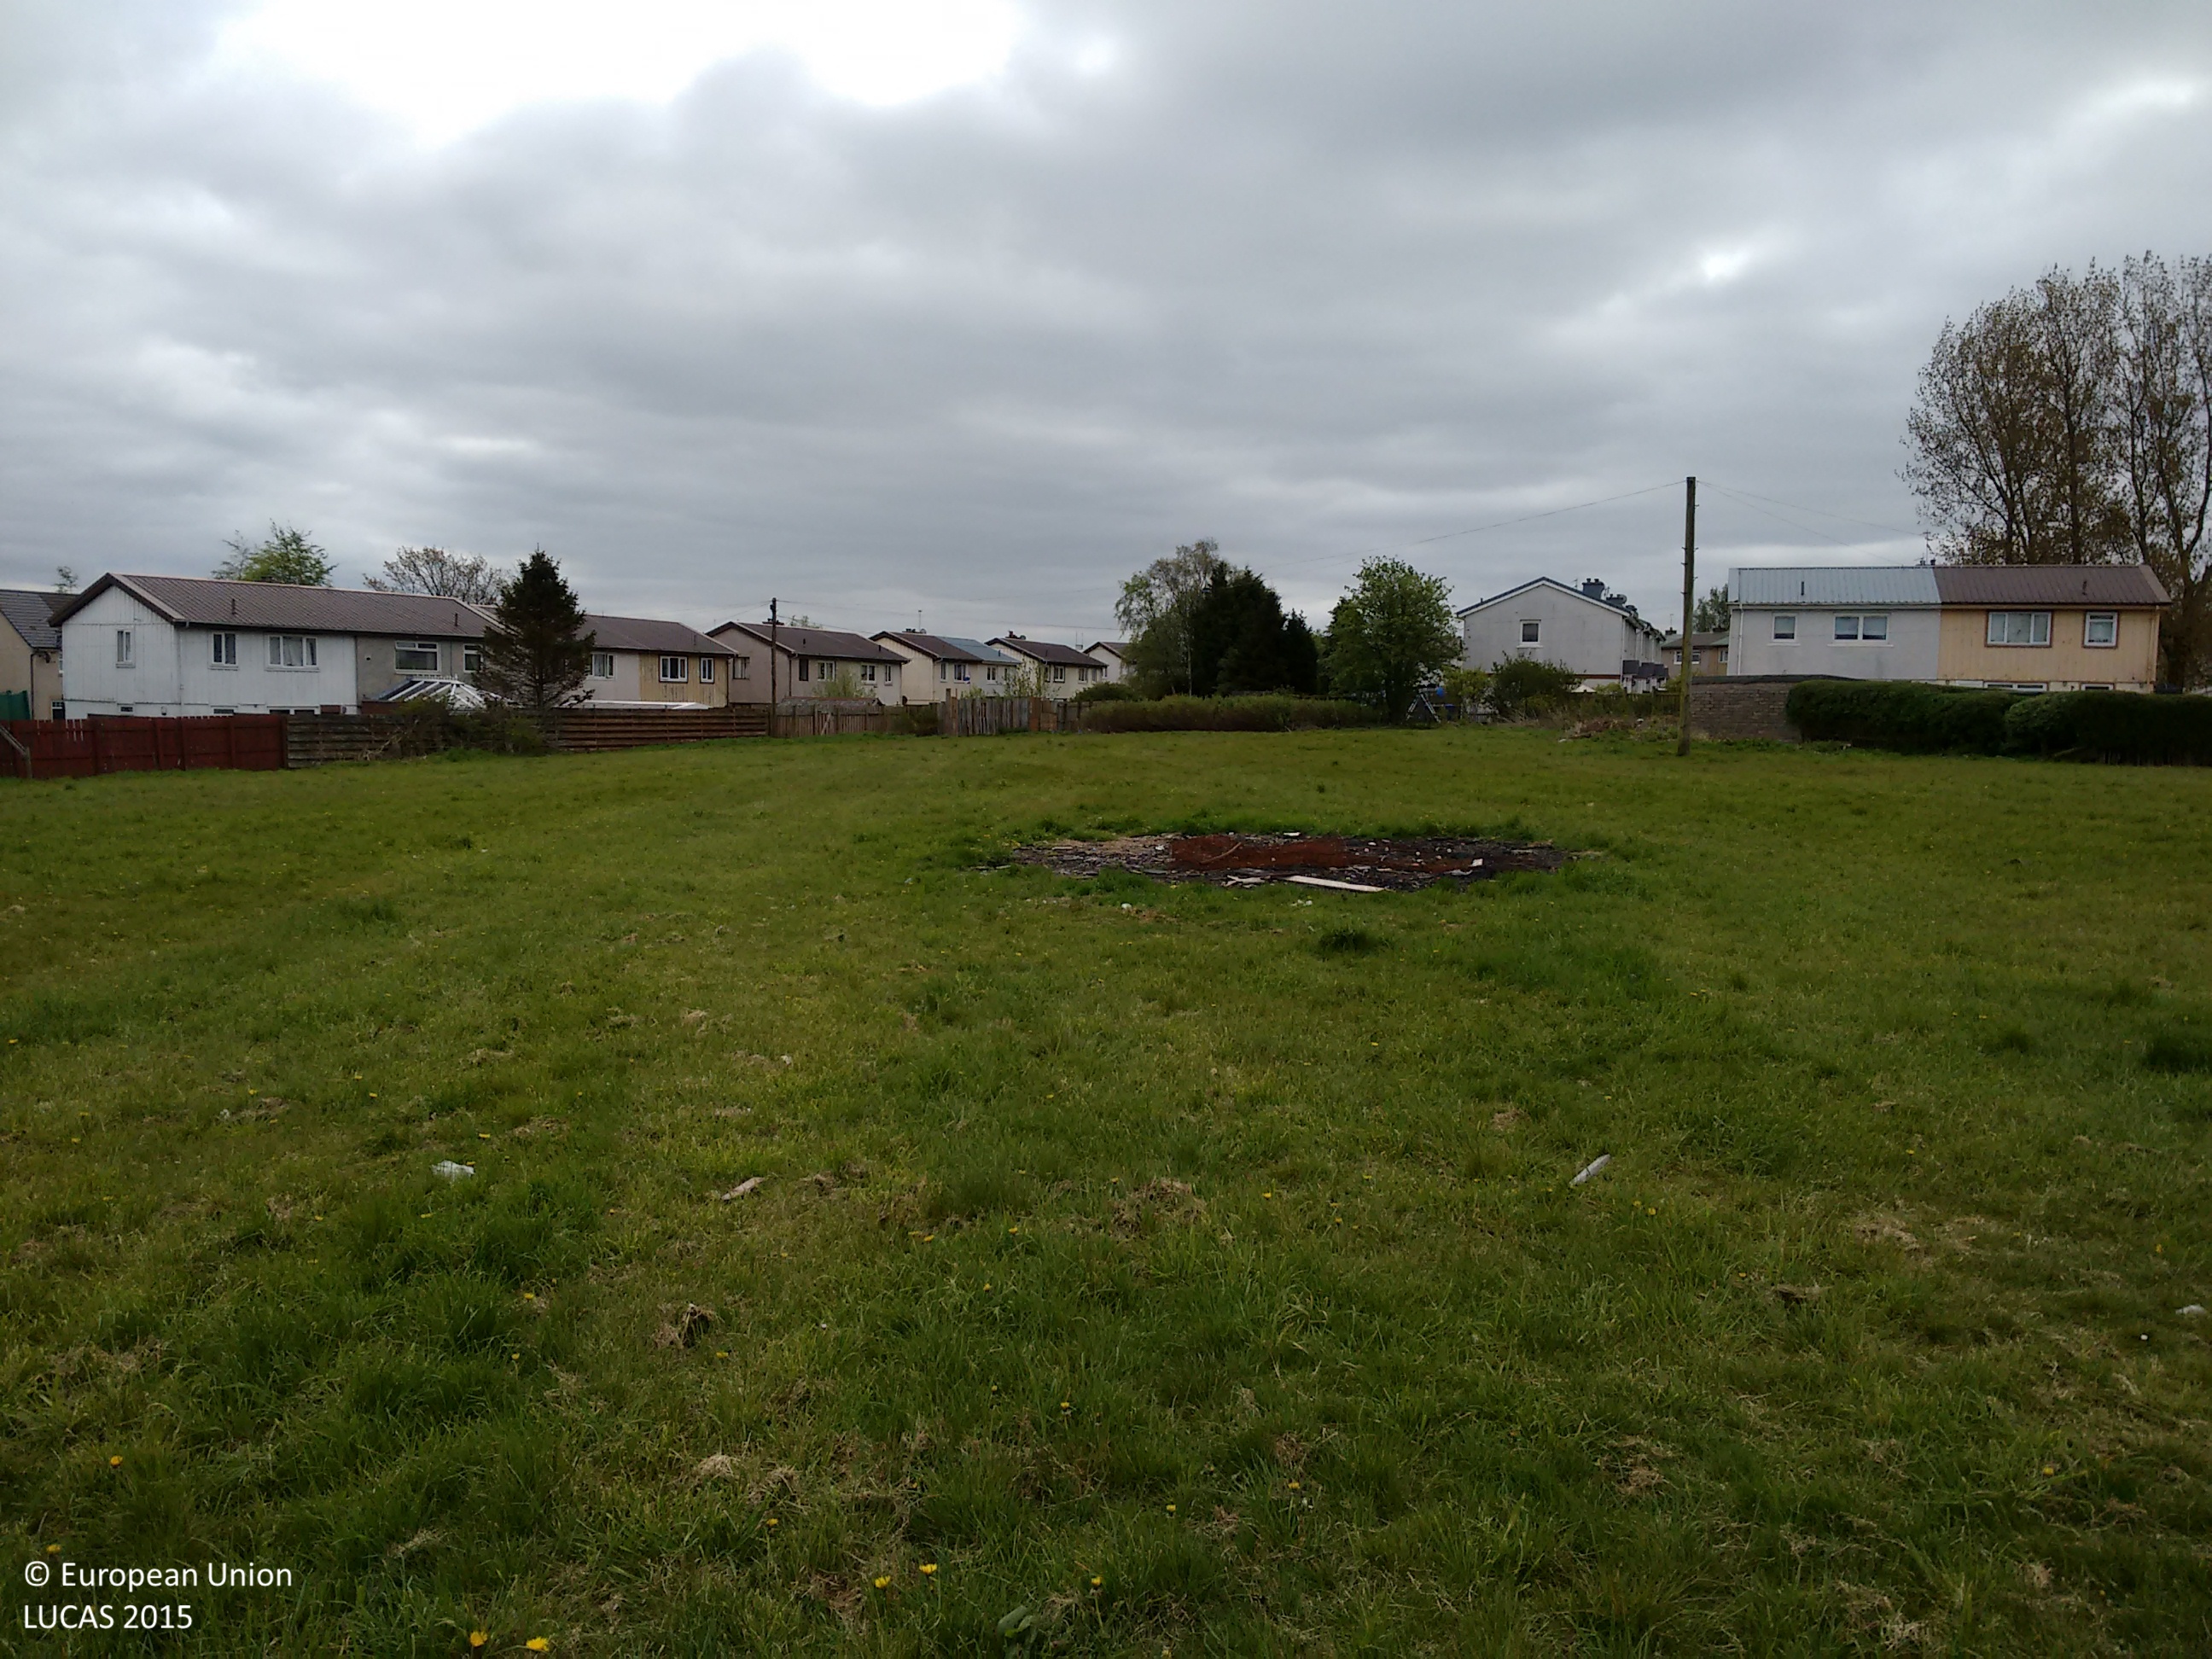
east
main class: Grassland
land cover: Grassland without tree/shrub cover
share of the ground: > 75 %
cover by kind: herbaceous plants 100 %
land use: Amenities, museums, leisure
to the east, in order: Grassland without tree/shrub cover; Artificial constructions in urban areas
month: May
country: GB
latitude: 55.8852
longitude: -4.2090
